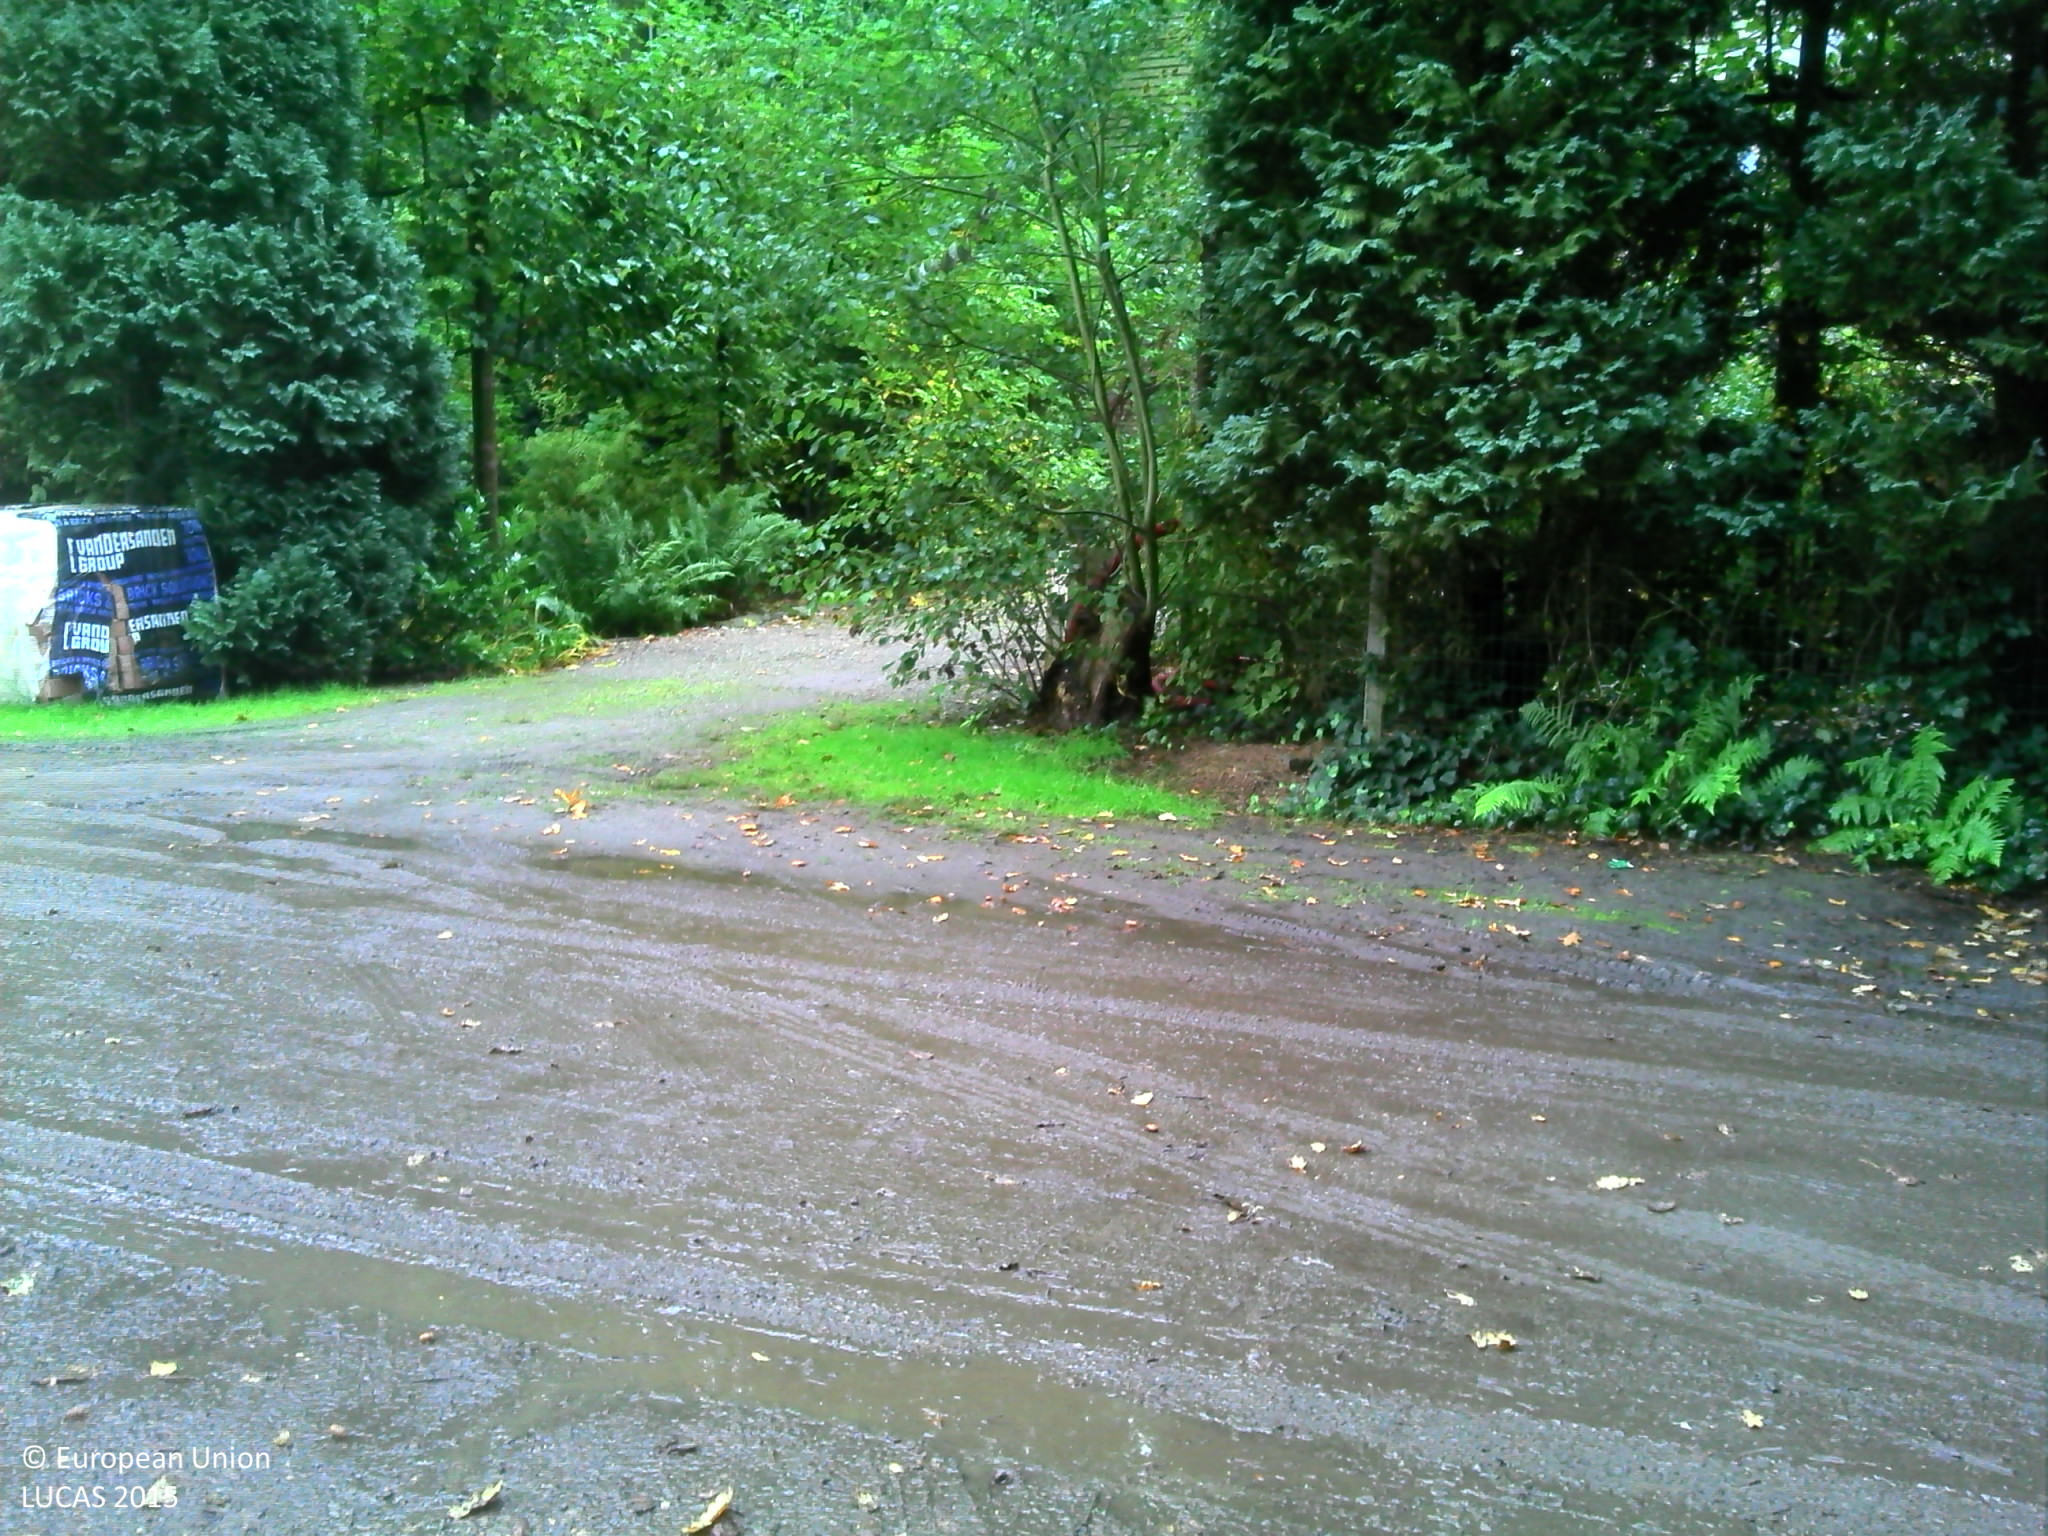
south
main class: Woodland
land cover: Other mixed woodland
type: exotic forest
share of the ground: > 75 %
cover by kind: broadleaved forest trees 70 %, coniferous forest trees 30 %
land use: Residential
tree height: > 5 m
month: October
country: BE
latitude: 50.9972
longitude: 4.6815
